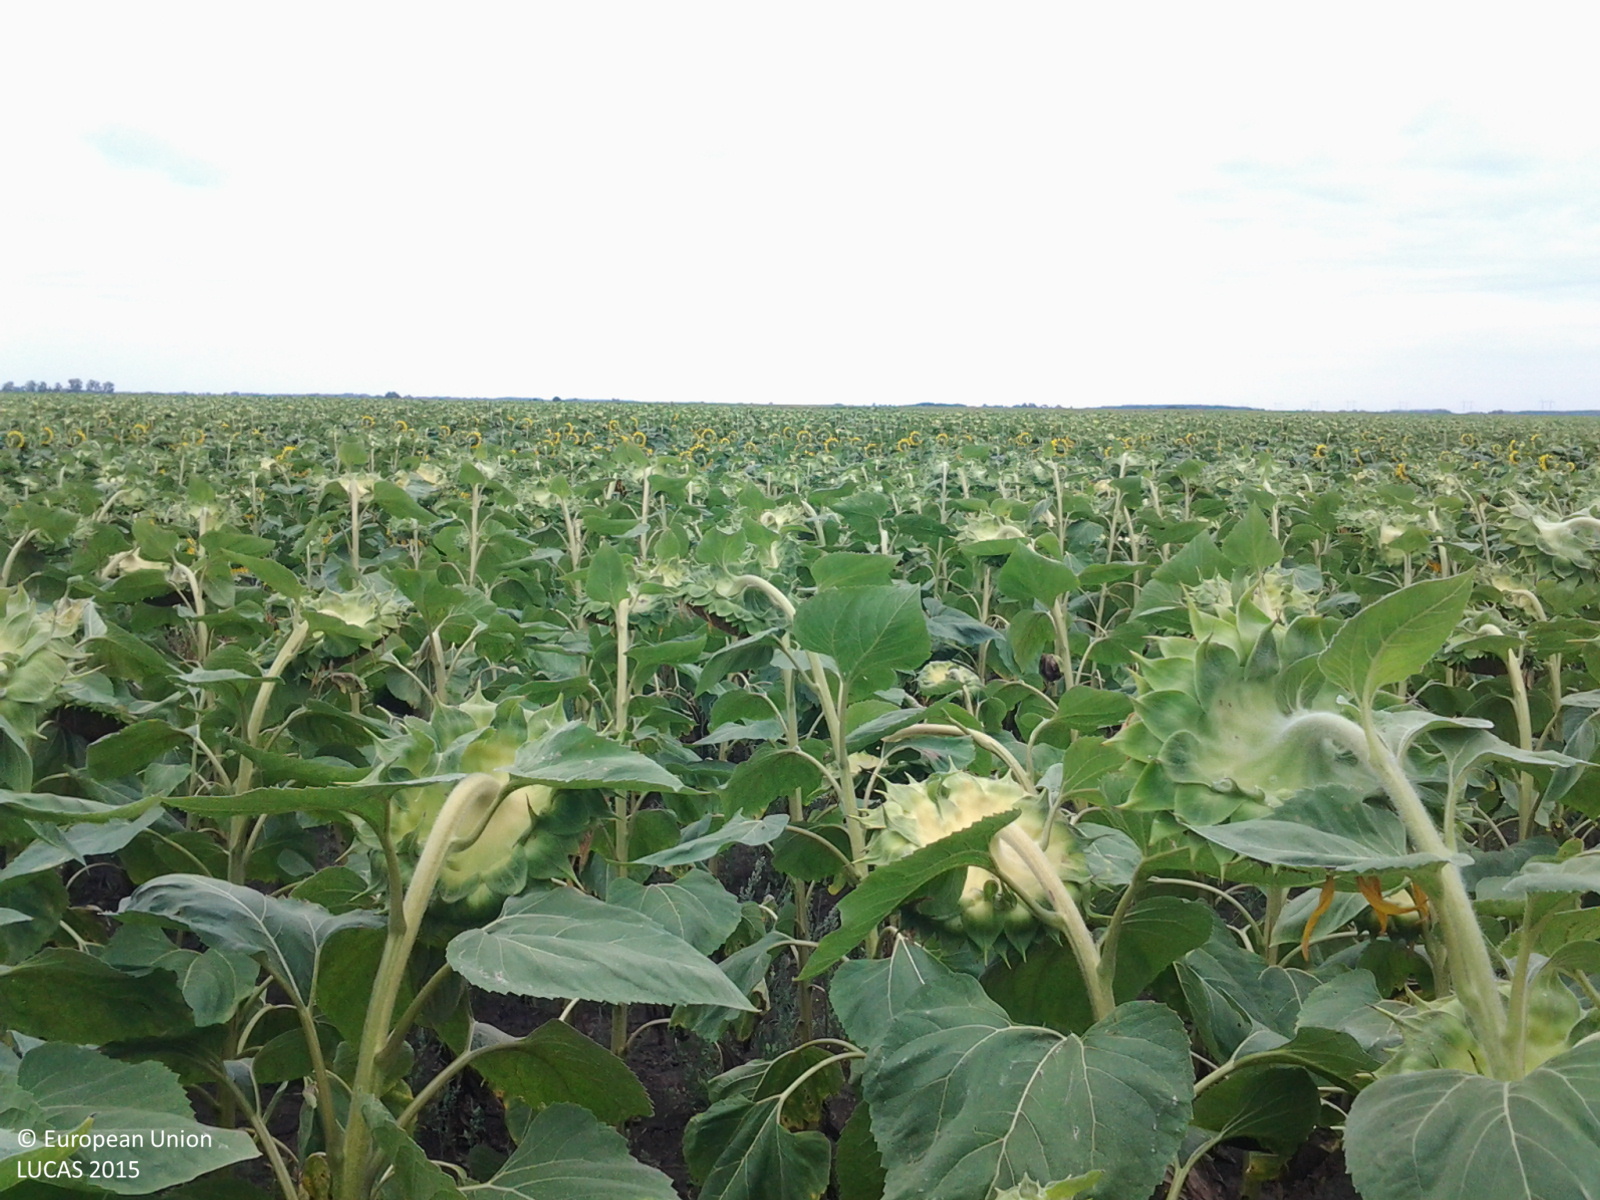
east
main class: Cropland
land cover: Sunflower
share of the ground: > 75 %
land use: Agriculture (excluding fallow land and kitchen gardens)
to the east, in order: Sunflower; Rice
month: July
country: HU
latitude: 47.3016
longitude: 20.5182
